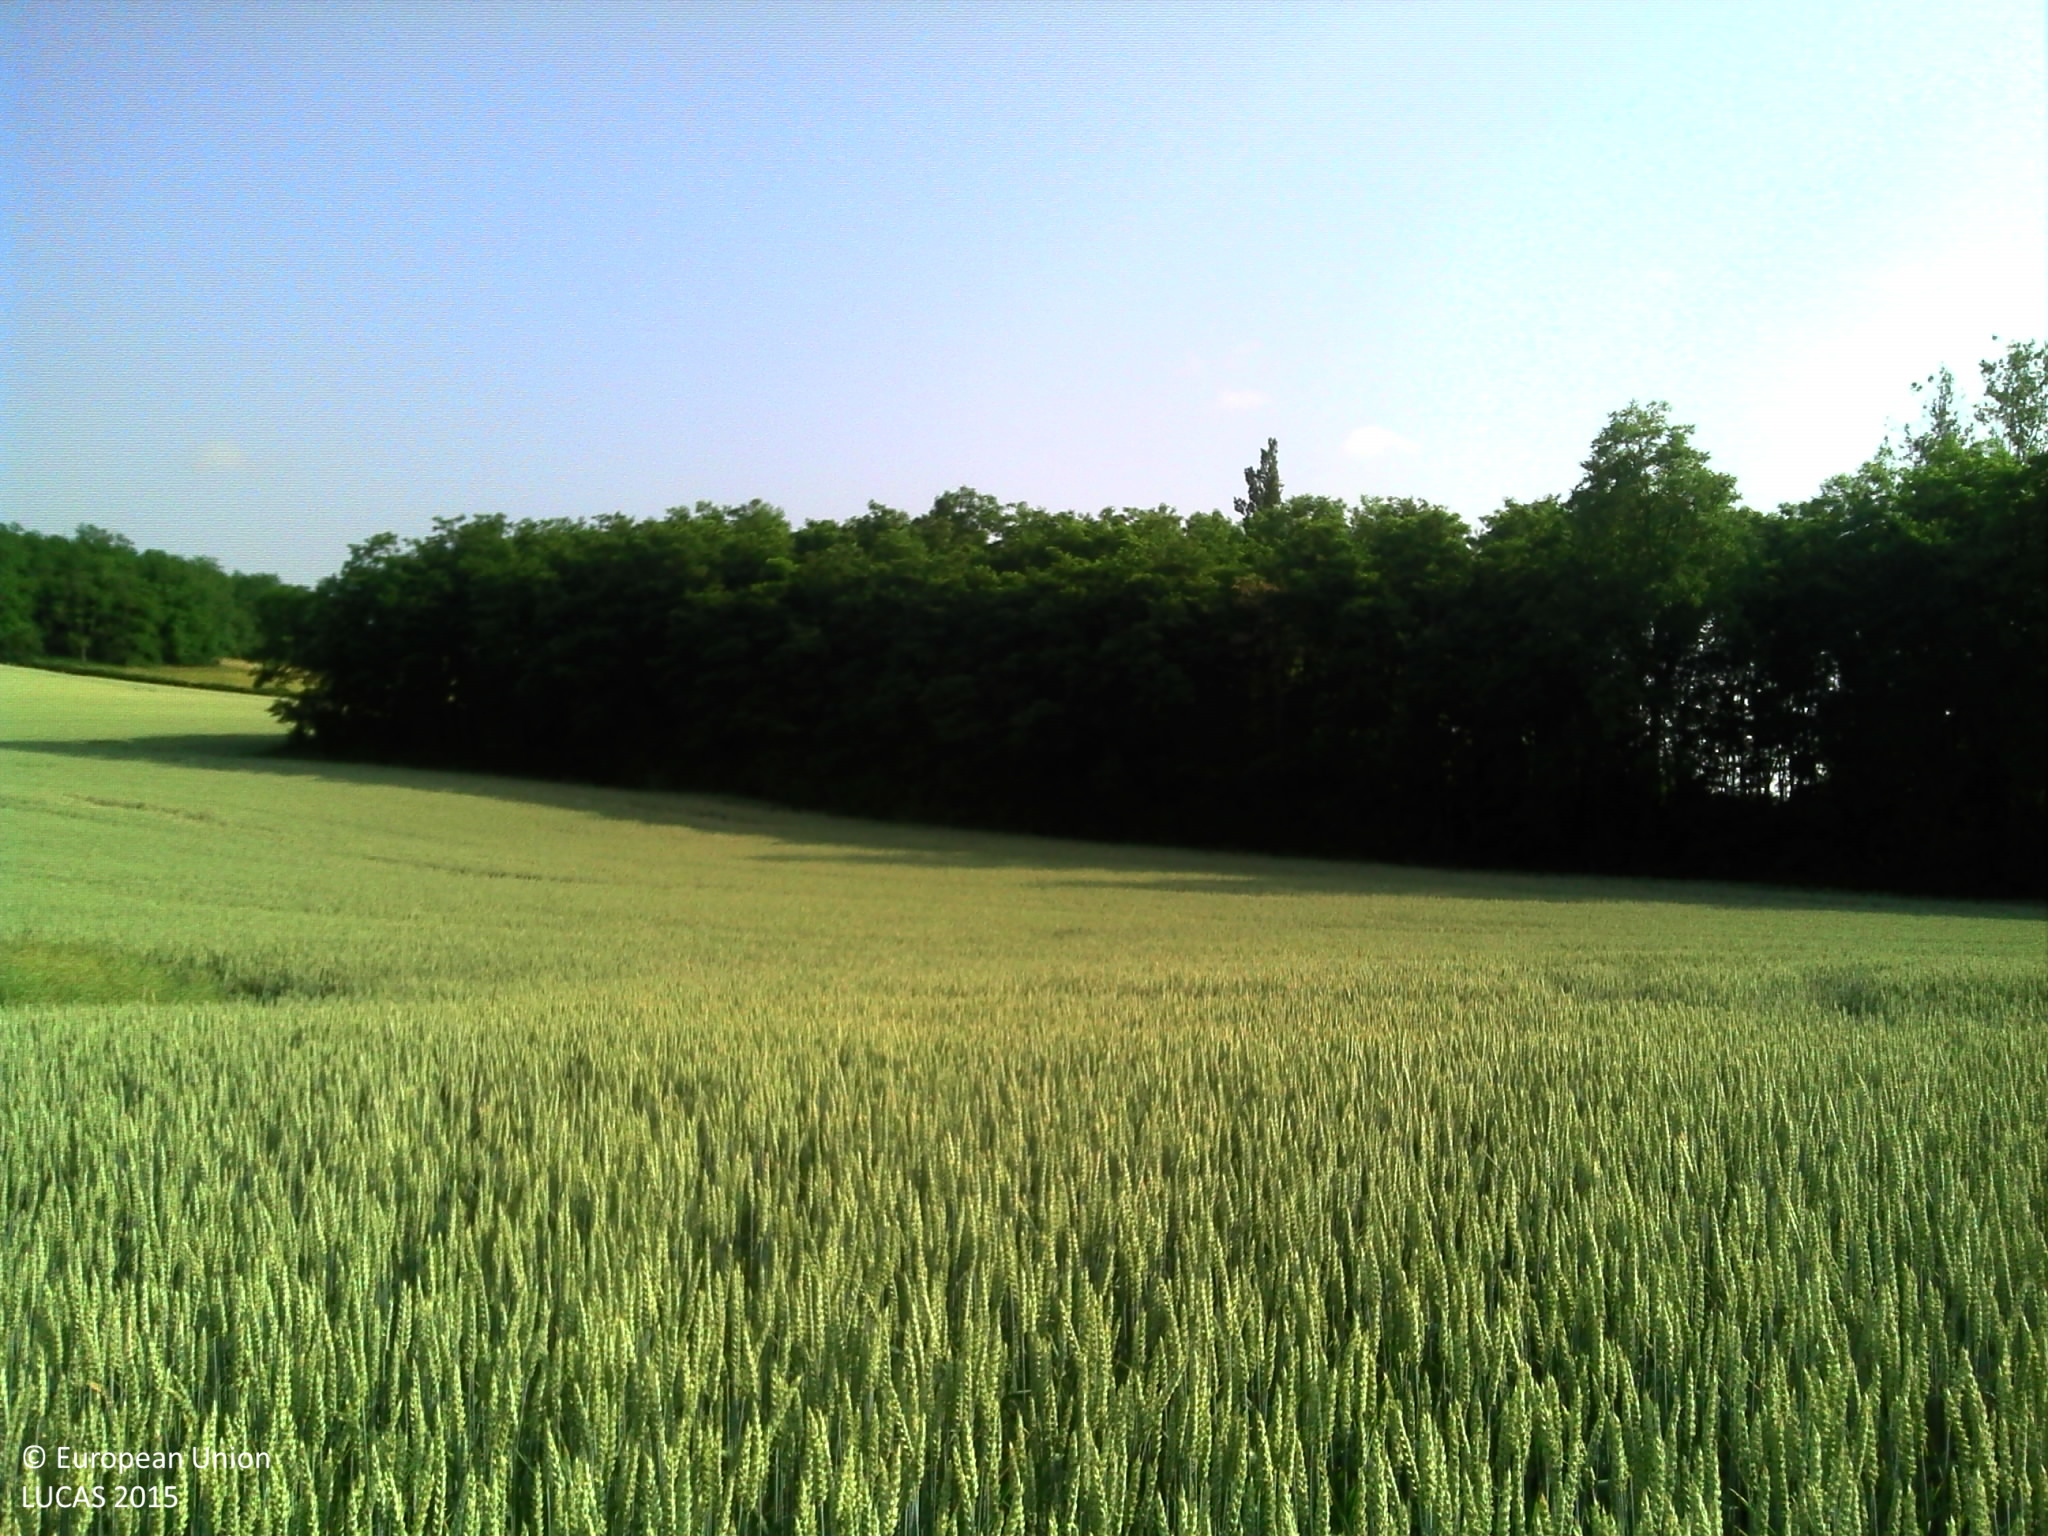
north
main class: Cropland
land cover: Rape and turnip rape
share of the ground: > 75 %
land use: Agriculture (excluding fallow land and kitchen gardens)
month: June
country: FR
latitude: 46.5173
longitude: 4.8794
